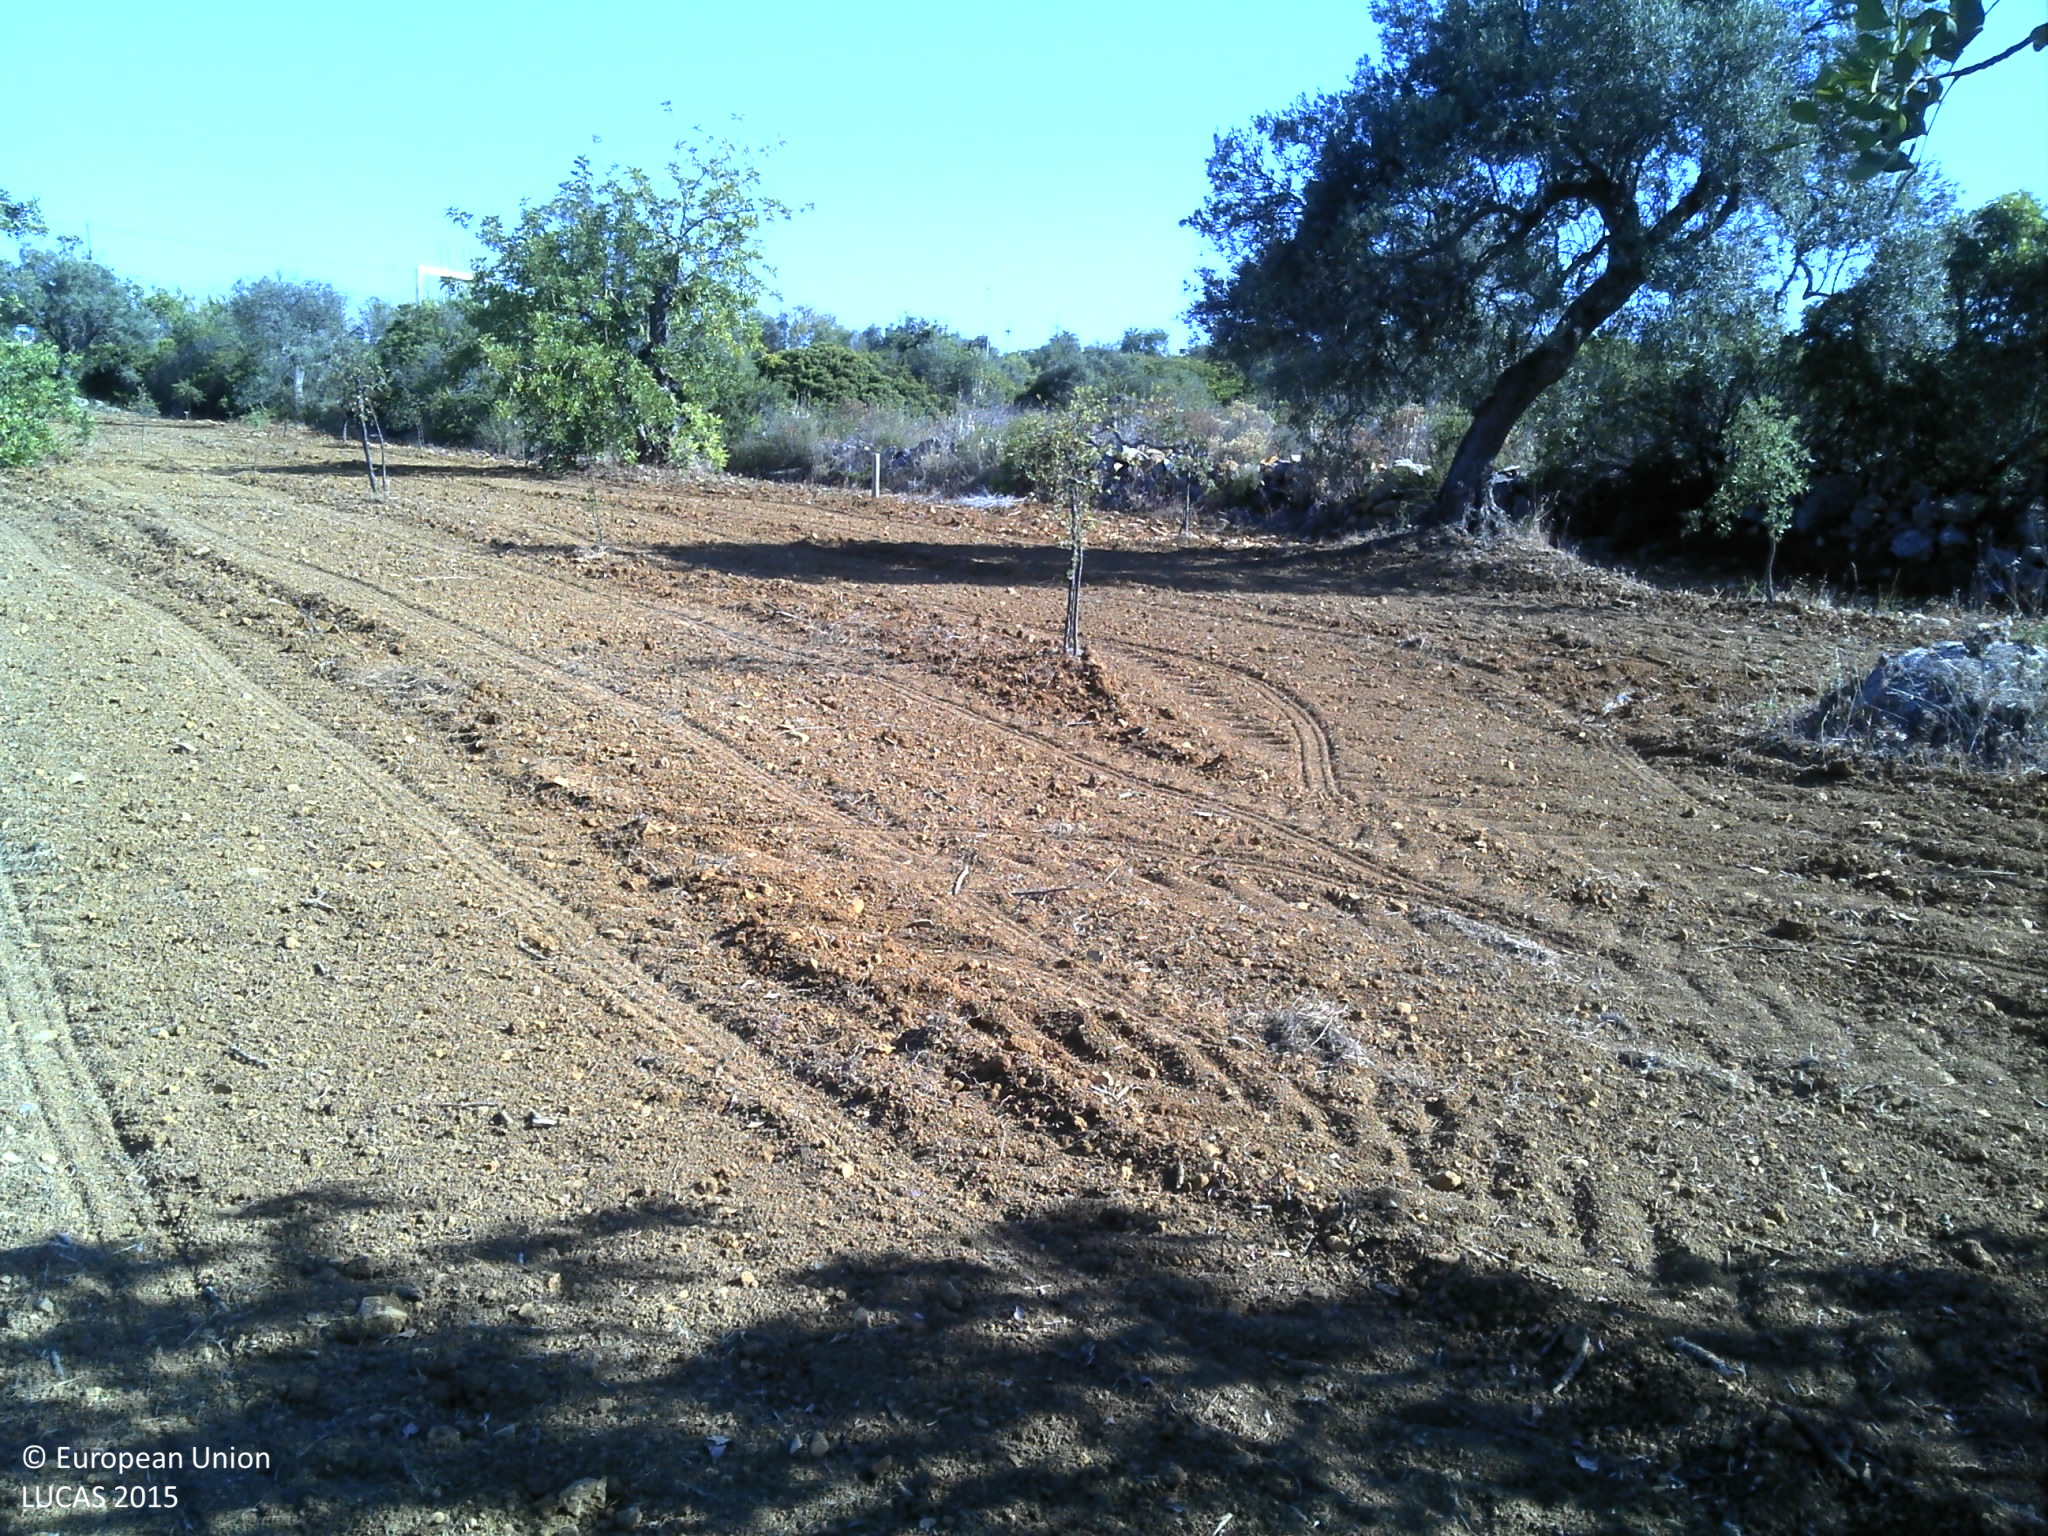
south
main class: Cropland
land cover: Permanent industrial crops
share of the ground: 10 - 25 %
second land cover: Other bare soil
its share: > 75 %
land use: Agriculture (excluding fallow land and kitchen gardens)
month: June
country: PT
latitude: 37.1088
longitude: -7.7987
